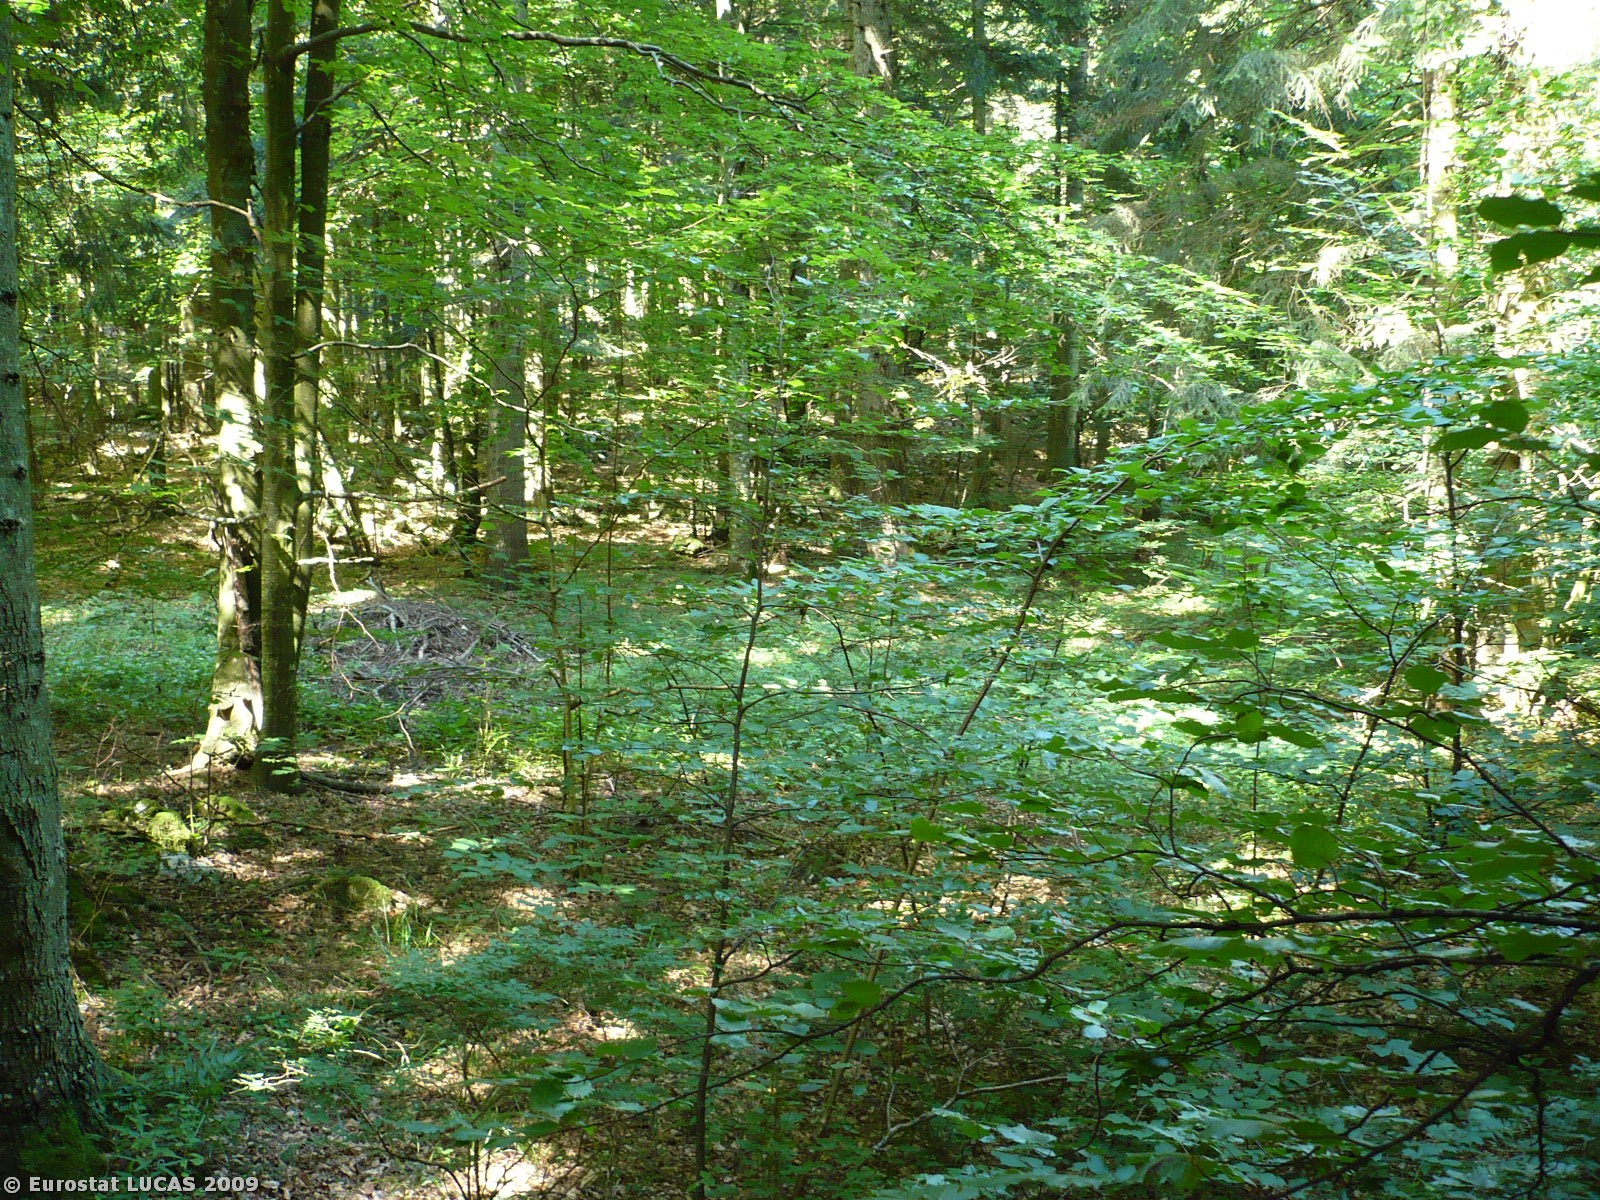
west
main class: Woodland
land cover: Mixed woodland
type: mountainous beech forest
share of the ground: > 75 %
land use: Forestry
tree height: > 5 m
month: July
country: SI
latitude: 45.7225
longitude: 14.3257
